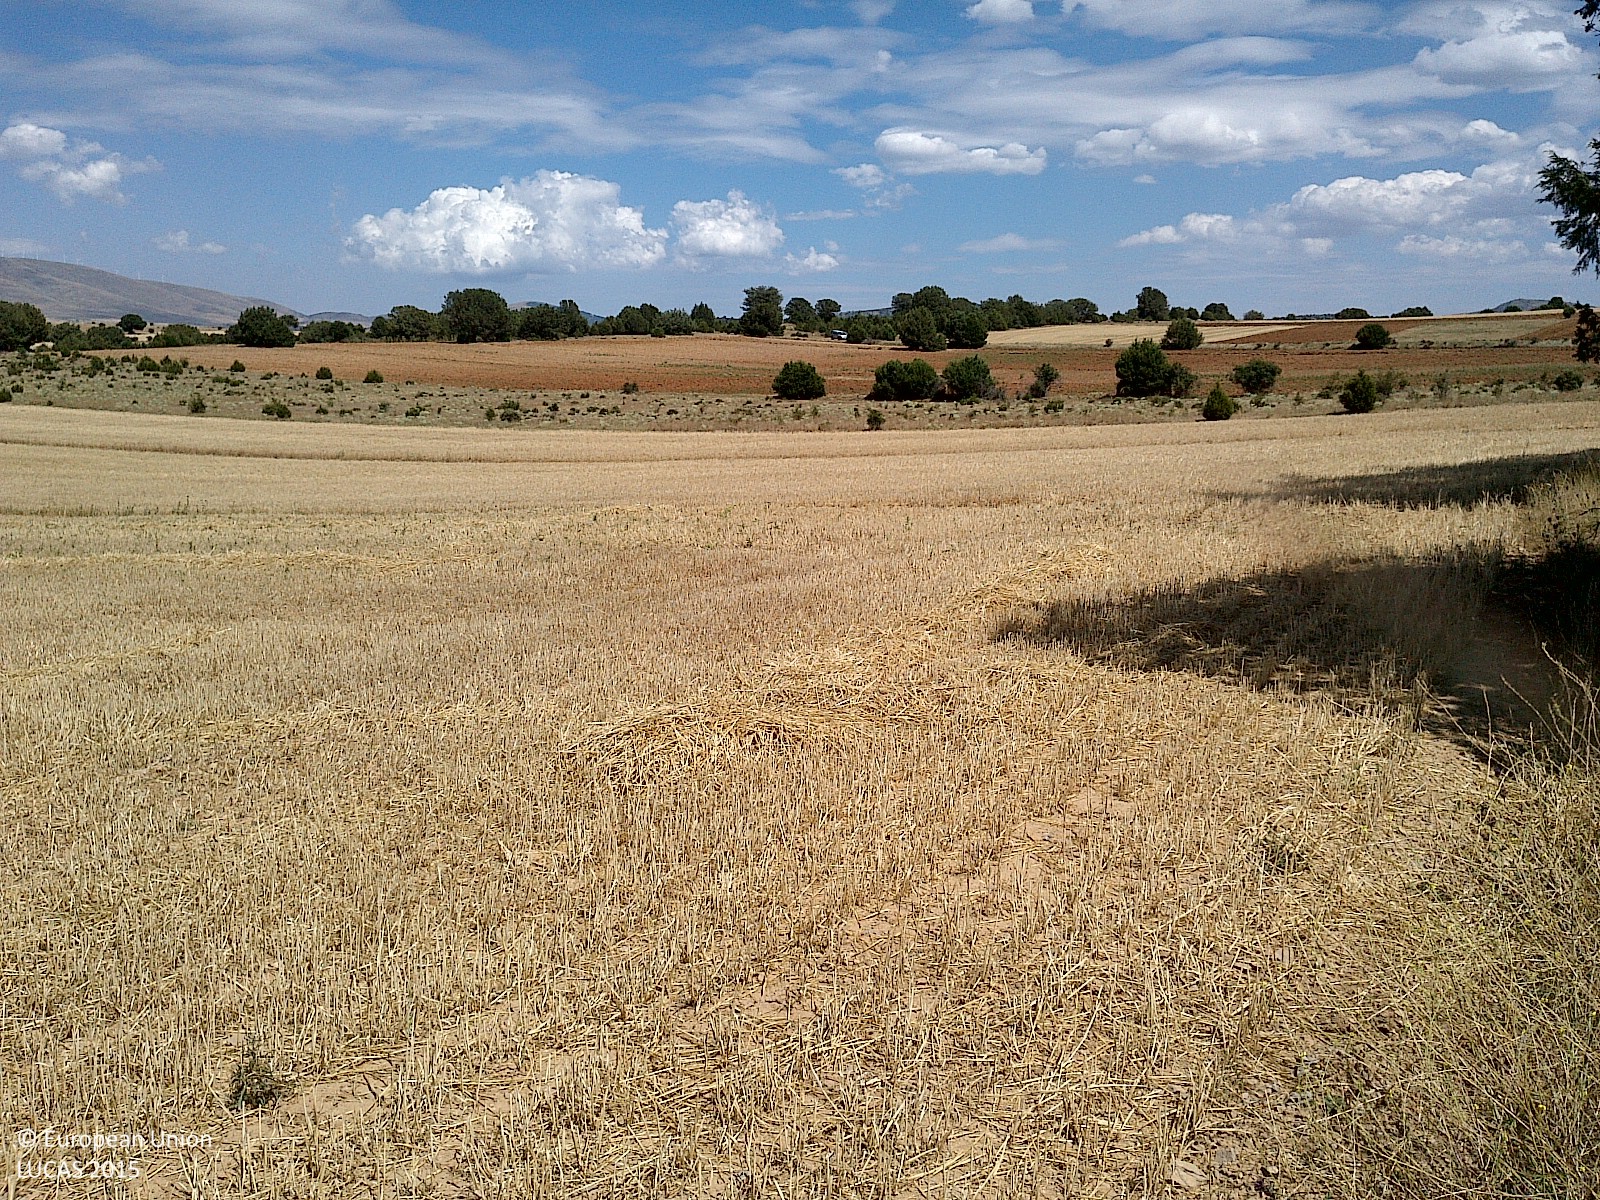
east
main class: Cropland
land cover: Barley
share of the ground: < 10 %
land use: Agriculture (excluding fallow land and kitchen gardens)
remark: Harvested field
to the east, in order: Barley; Grassland without tree/shrub cover; Grassland with sparse tree/shrub cover; Other bare soil
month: July
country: ES
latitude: 41.6514
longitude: -1.9547
